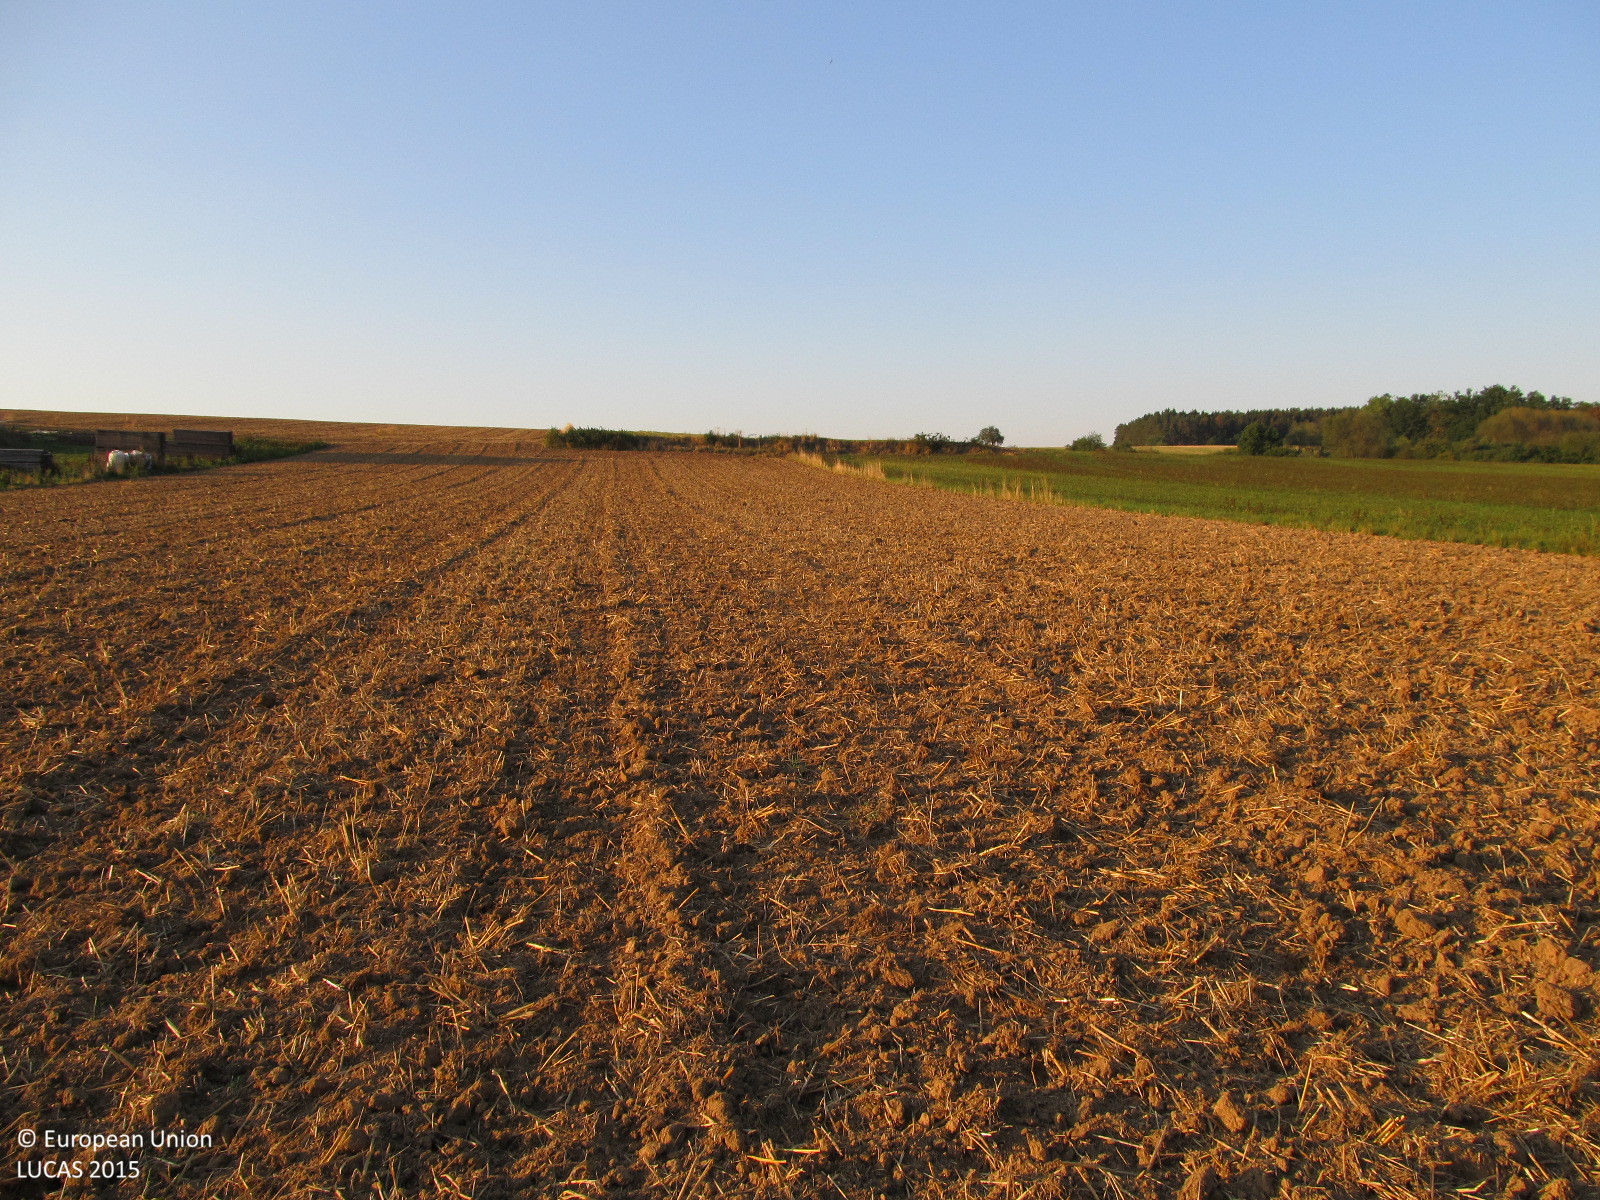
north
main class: Cropland
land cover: Common wheat
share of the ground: < 10 %
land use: Agriculture (excluding fallow land and kitchen gardens)
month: August
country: AT
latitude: 48.7722
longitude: 15.4866
